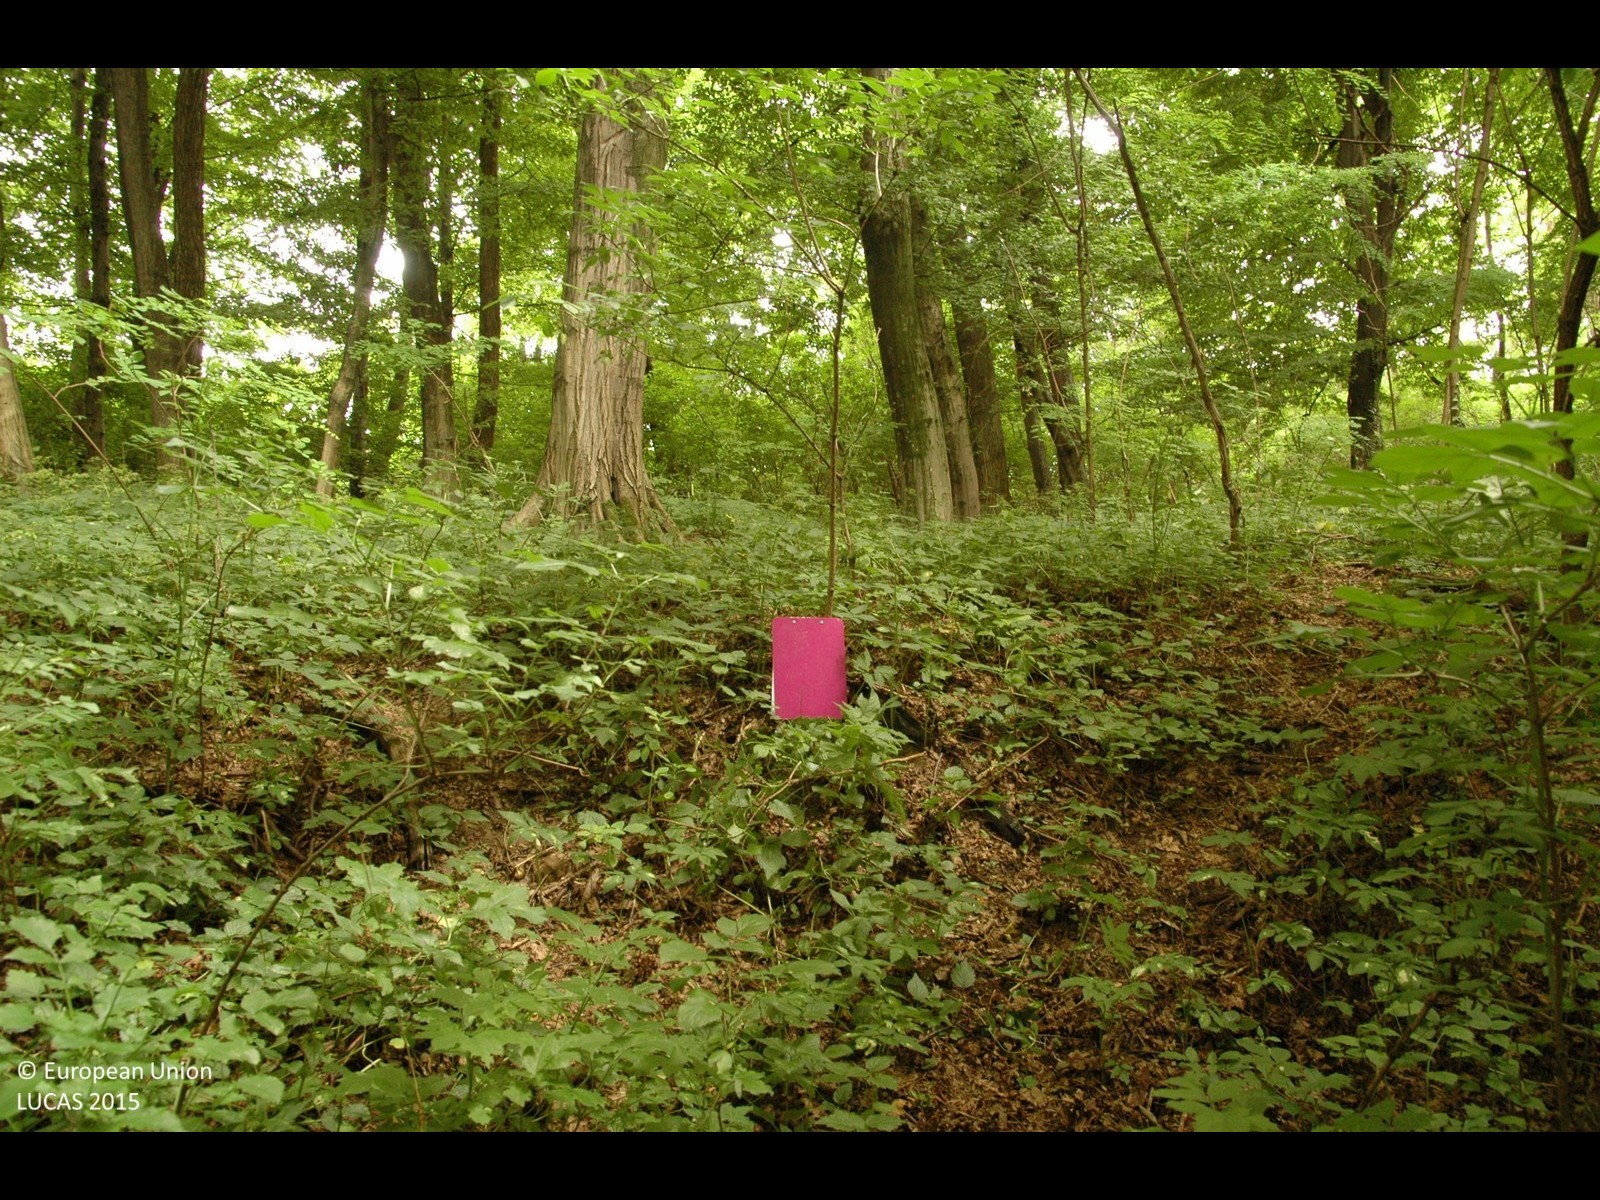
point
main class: Woodland
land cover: Broadleaved woodland
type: mesophytic deciduous forest
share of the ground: > 75 %
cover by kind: broadleaved forest trees 100 %
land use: Forestry
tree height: > 5 m
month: June
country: HR
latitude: 46.4505
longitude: 16.3666
